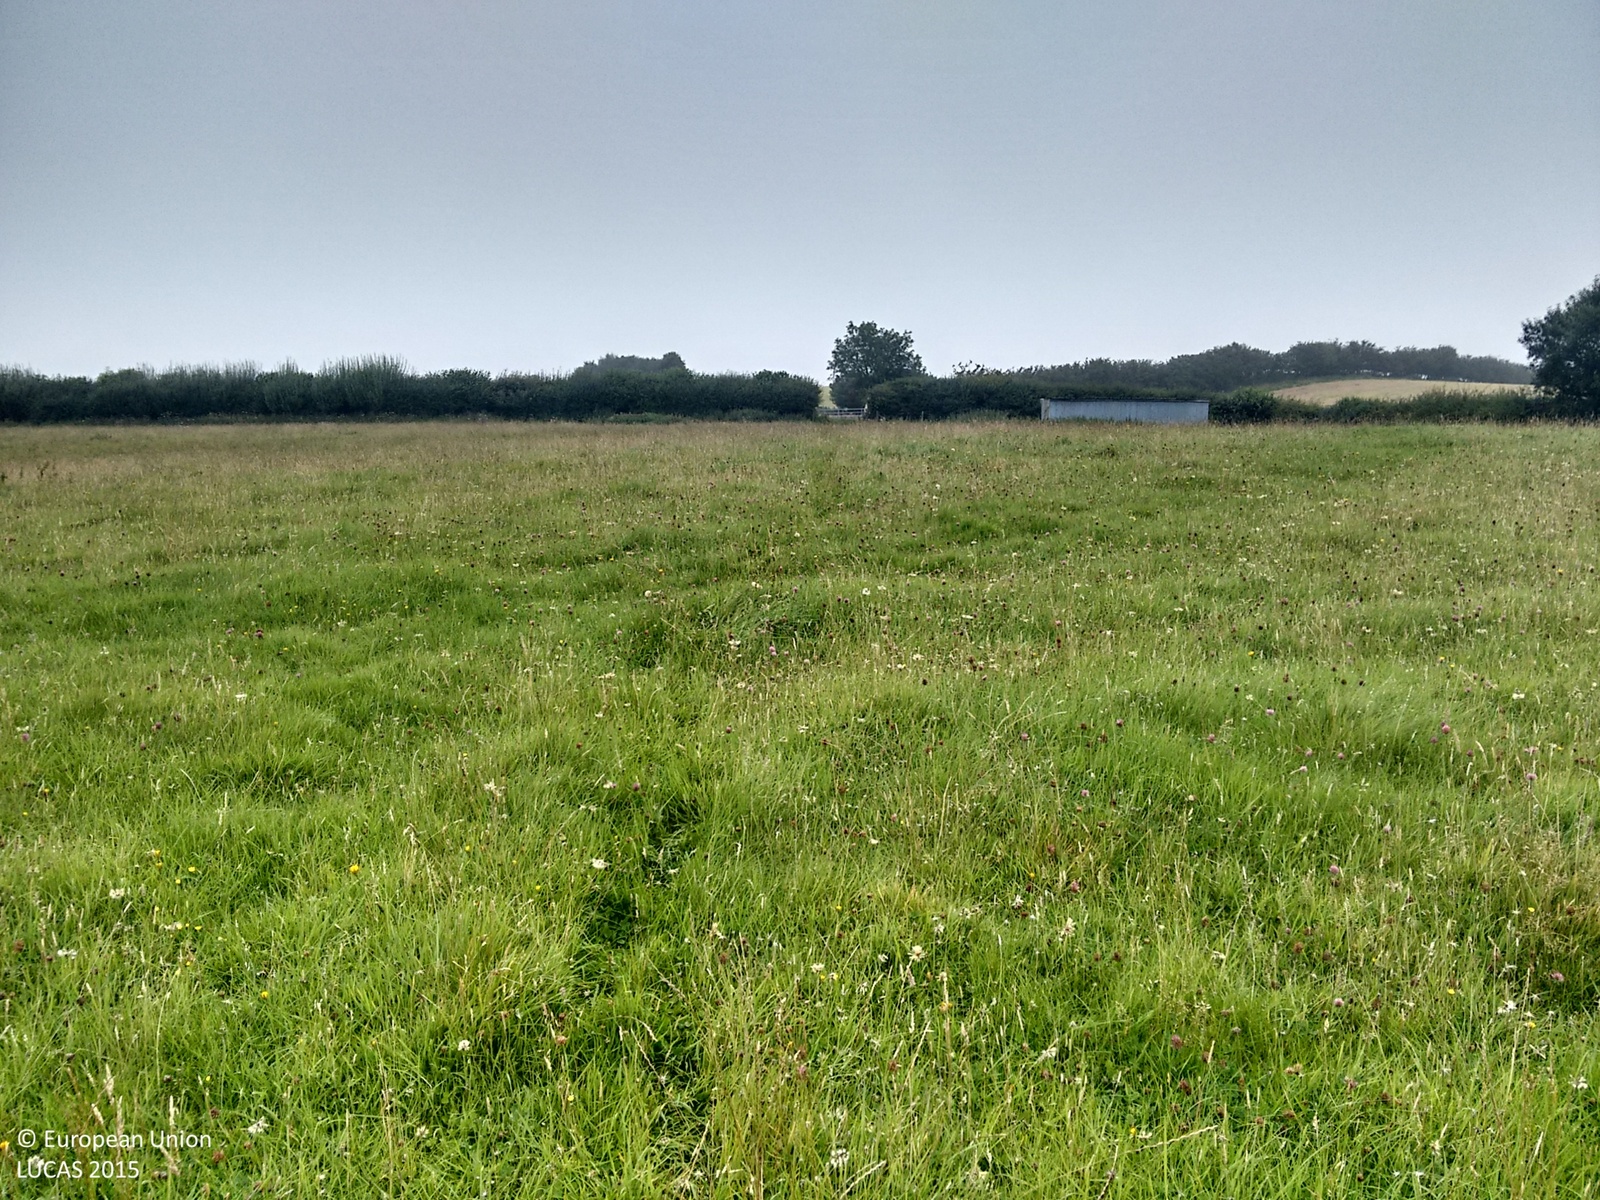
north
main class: Grassland
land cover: Grassland without tree/shrub cover
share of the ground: > 75 %
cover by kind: herbaceous plants 100 %
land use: Agriculture (excluding fallow land and kitchen gardens)
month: September
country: GB
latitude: 52.1335
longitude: -3.1533
